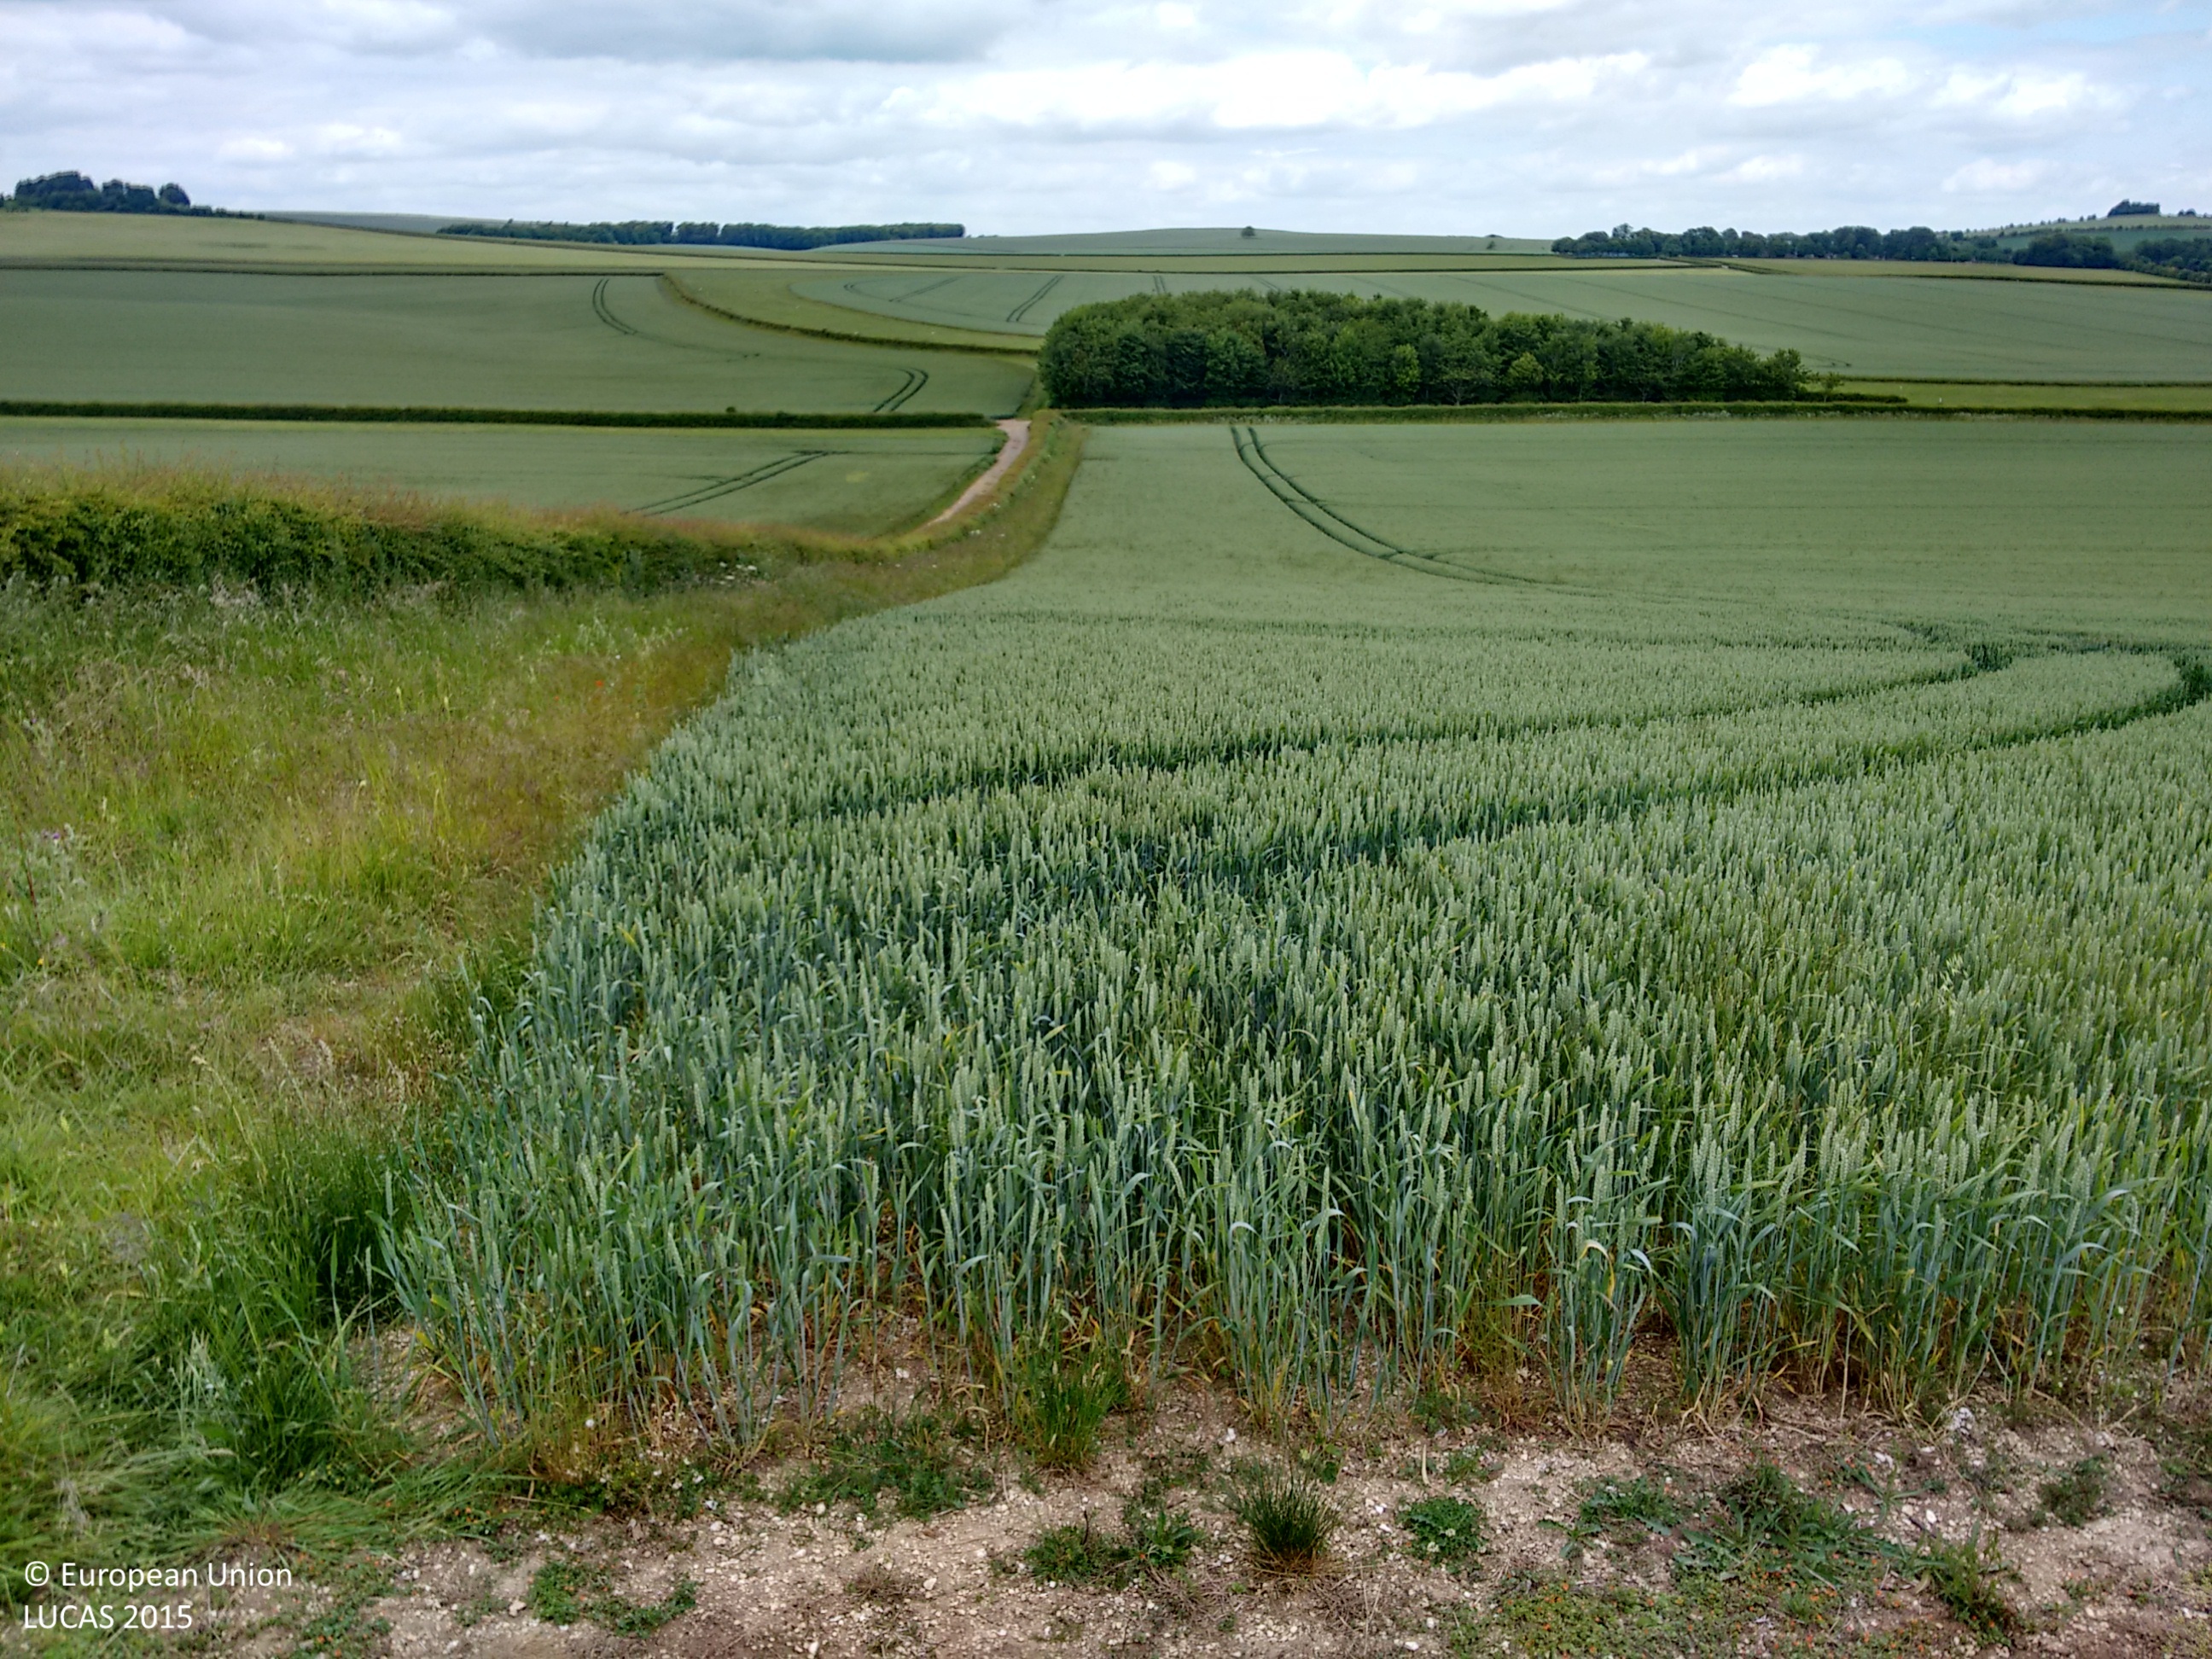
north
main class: Cropland
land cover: Common wheat
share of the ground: > 75 %
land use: Agriculture (excluding fallow land and kitchen gardens)
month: June
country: GB
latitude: 51.5574
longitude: -1.5475
